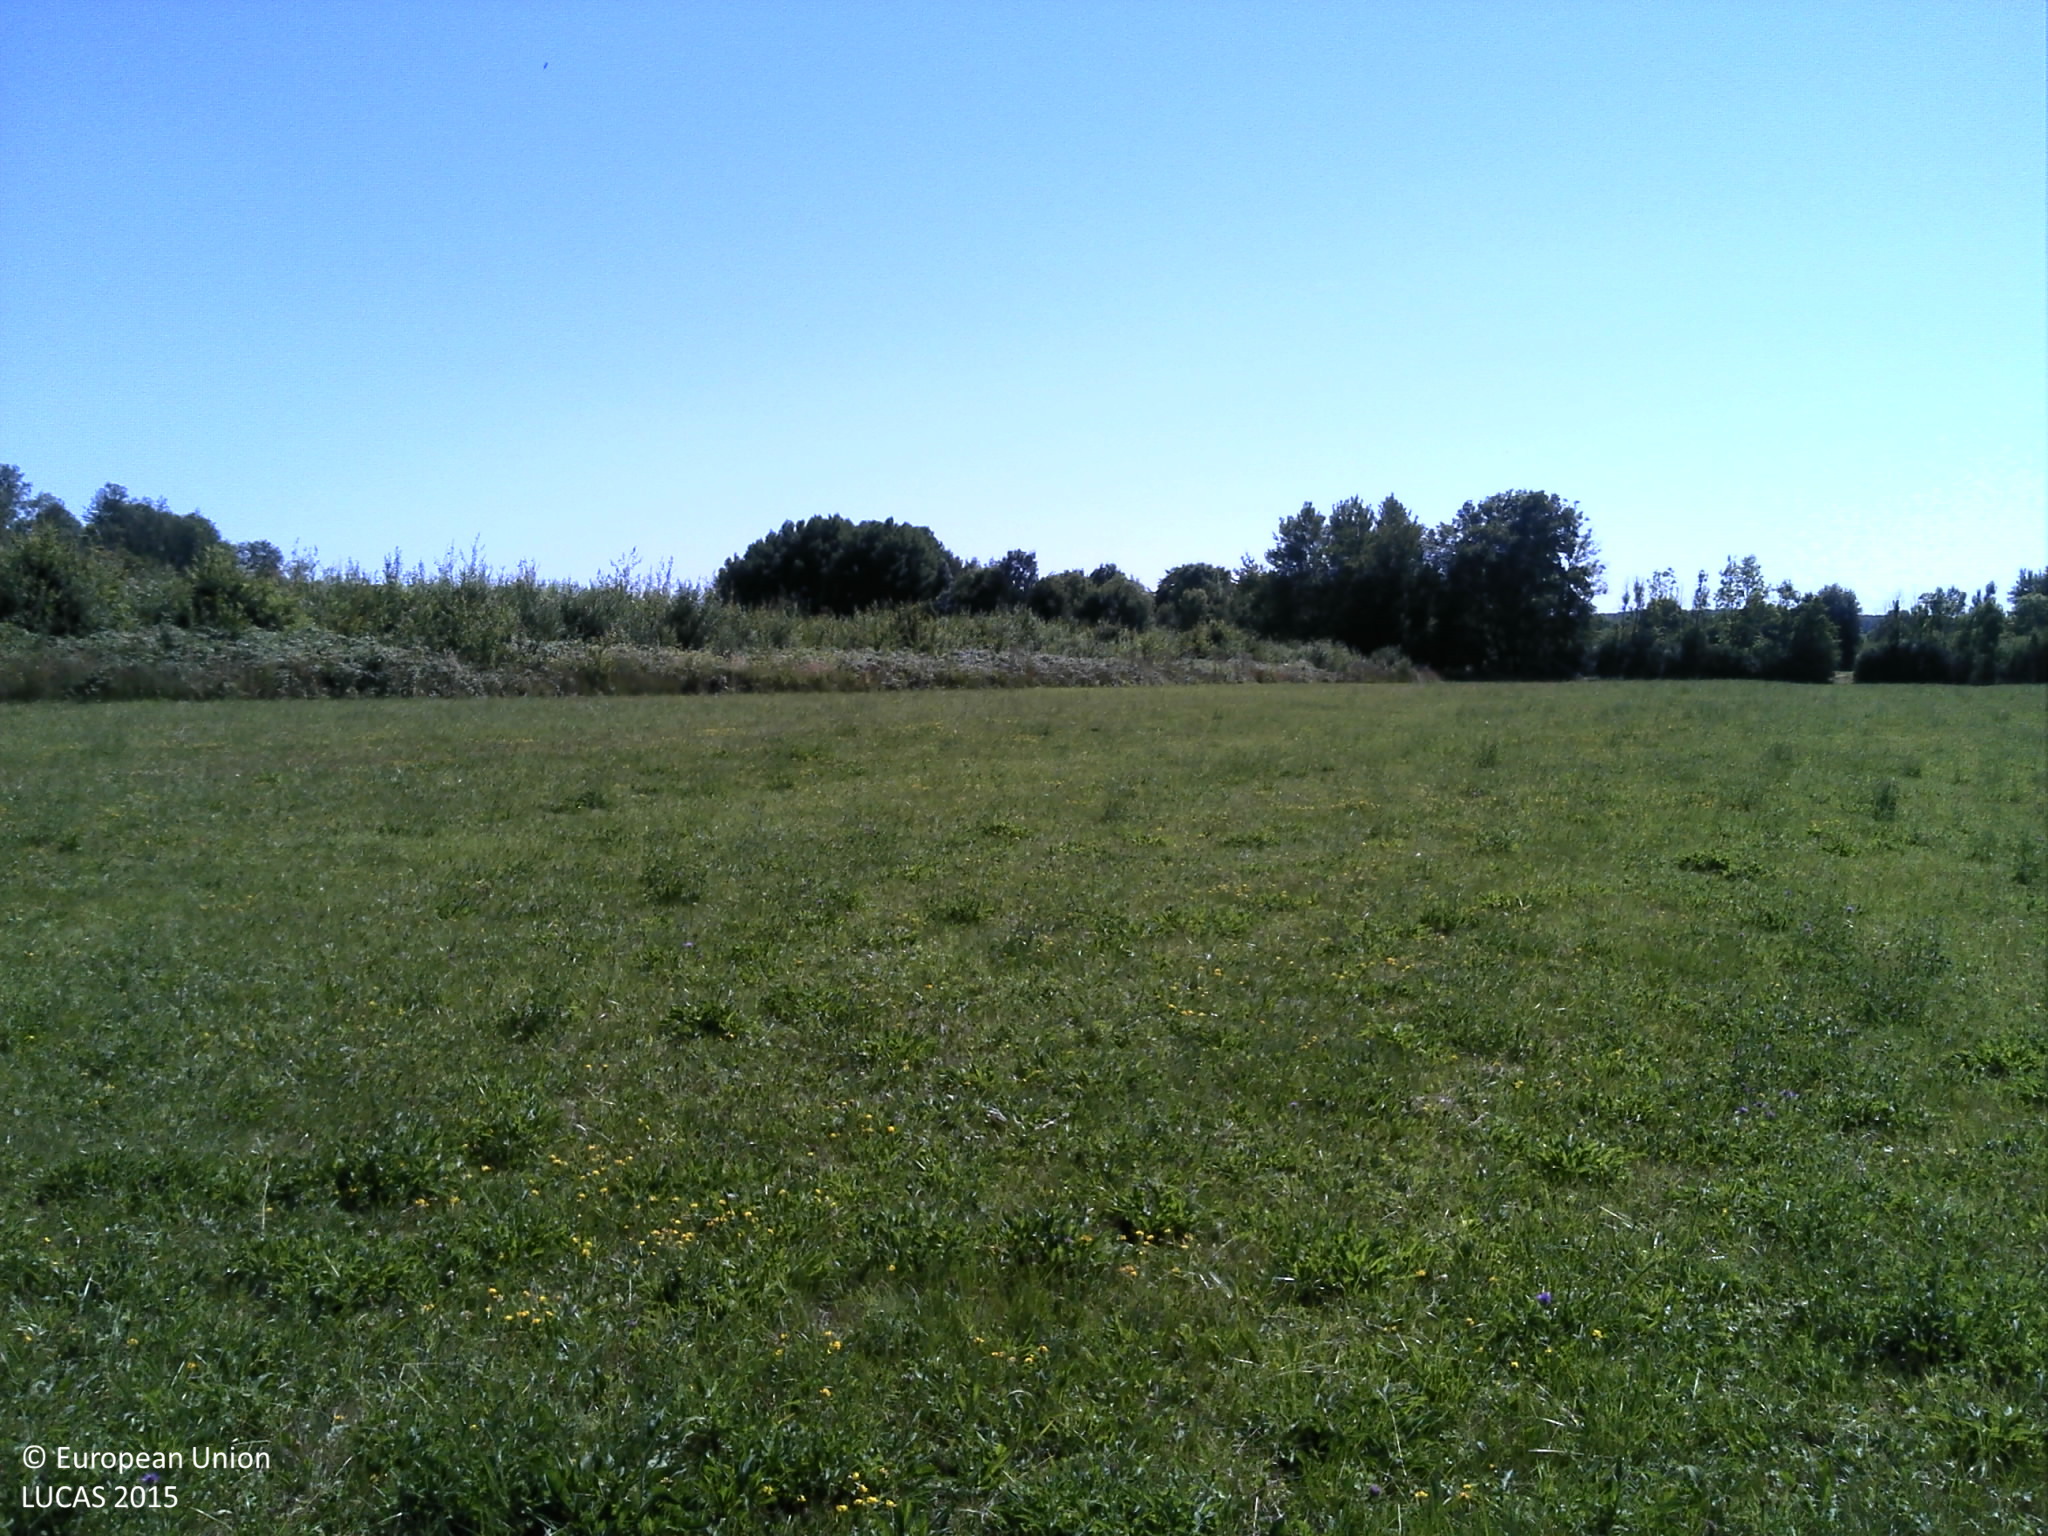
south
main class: Grassland
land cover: Grassland without tree/shrub cover
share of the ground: > 75 %
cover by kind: herbaceous plants 100 %
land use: Agriculture (excluding fallow land and kitchen gardens)
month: July
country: FR
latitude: 49.5040
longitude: 4.7356
